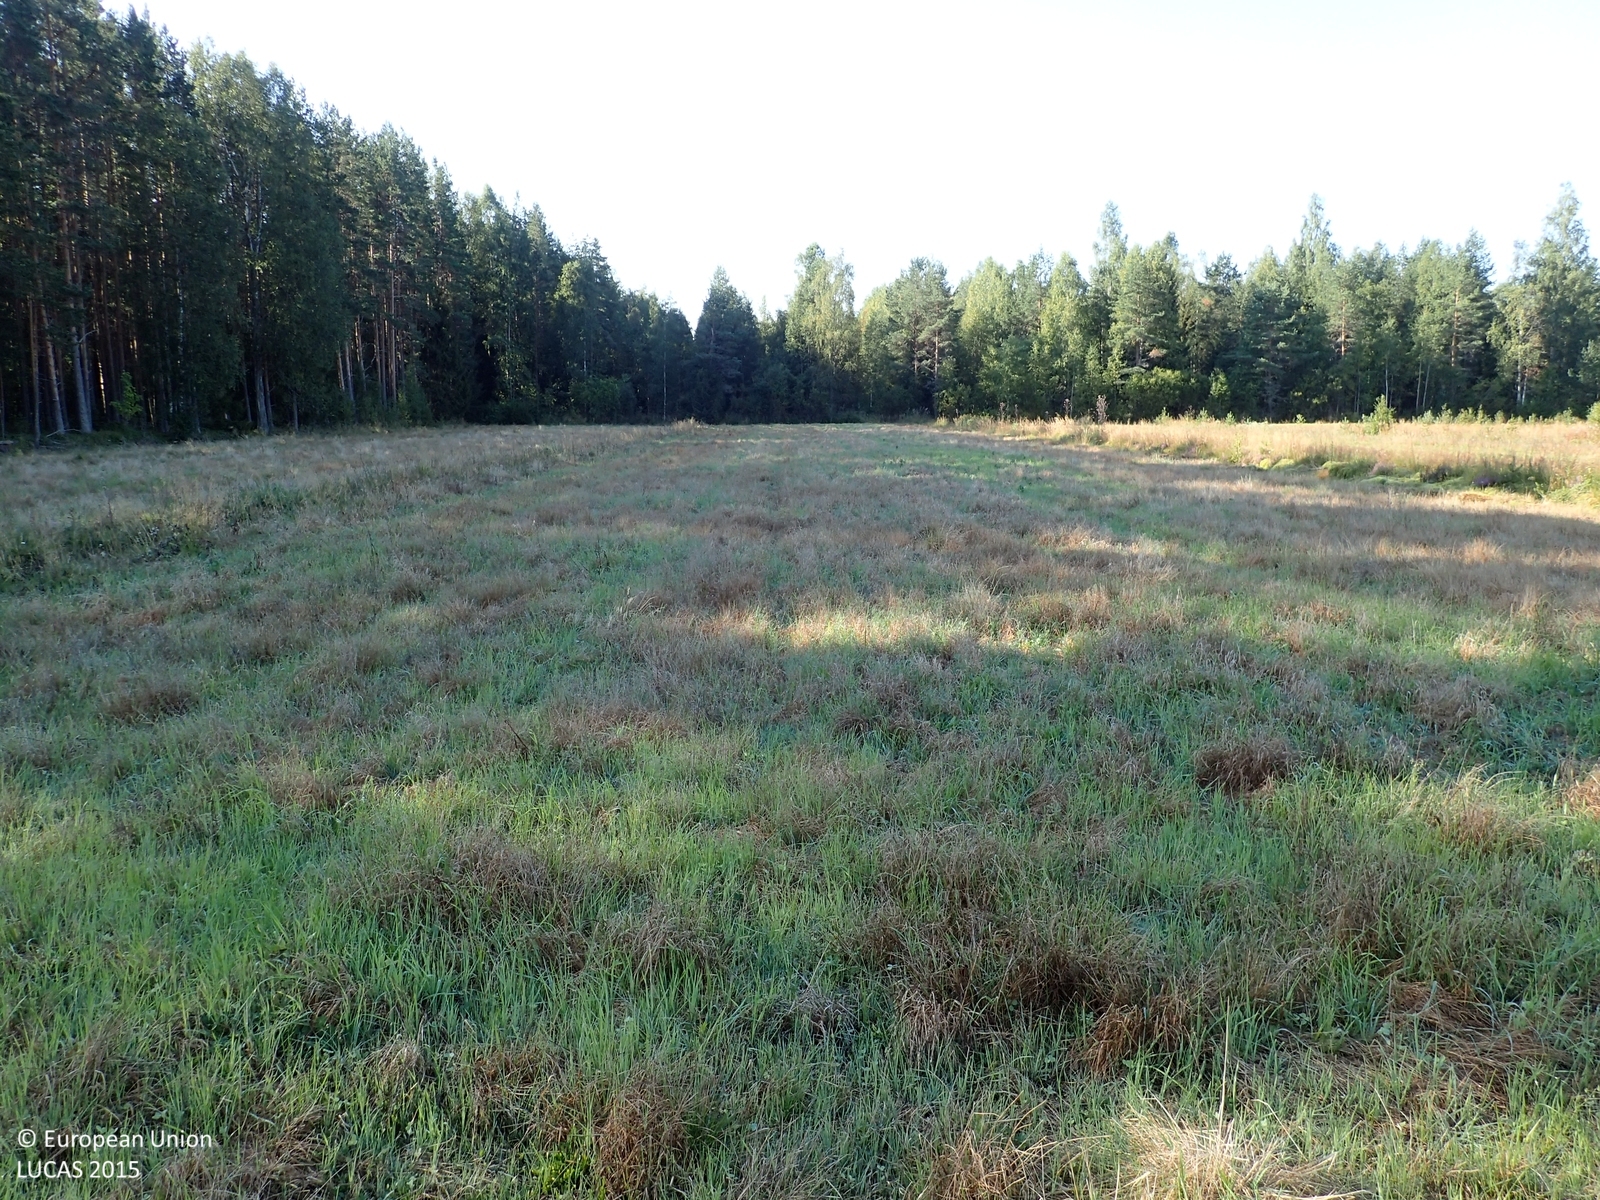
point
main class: Cropland
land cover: Temporary grasslands
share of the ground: > 75 %
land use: Agriculture (excluding fallow land and kitchen gardens)
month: August
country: FI
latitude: 62.4617
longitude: 21.9726
